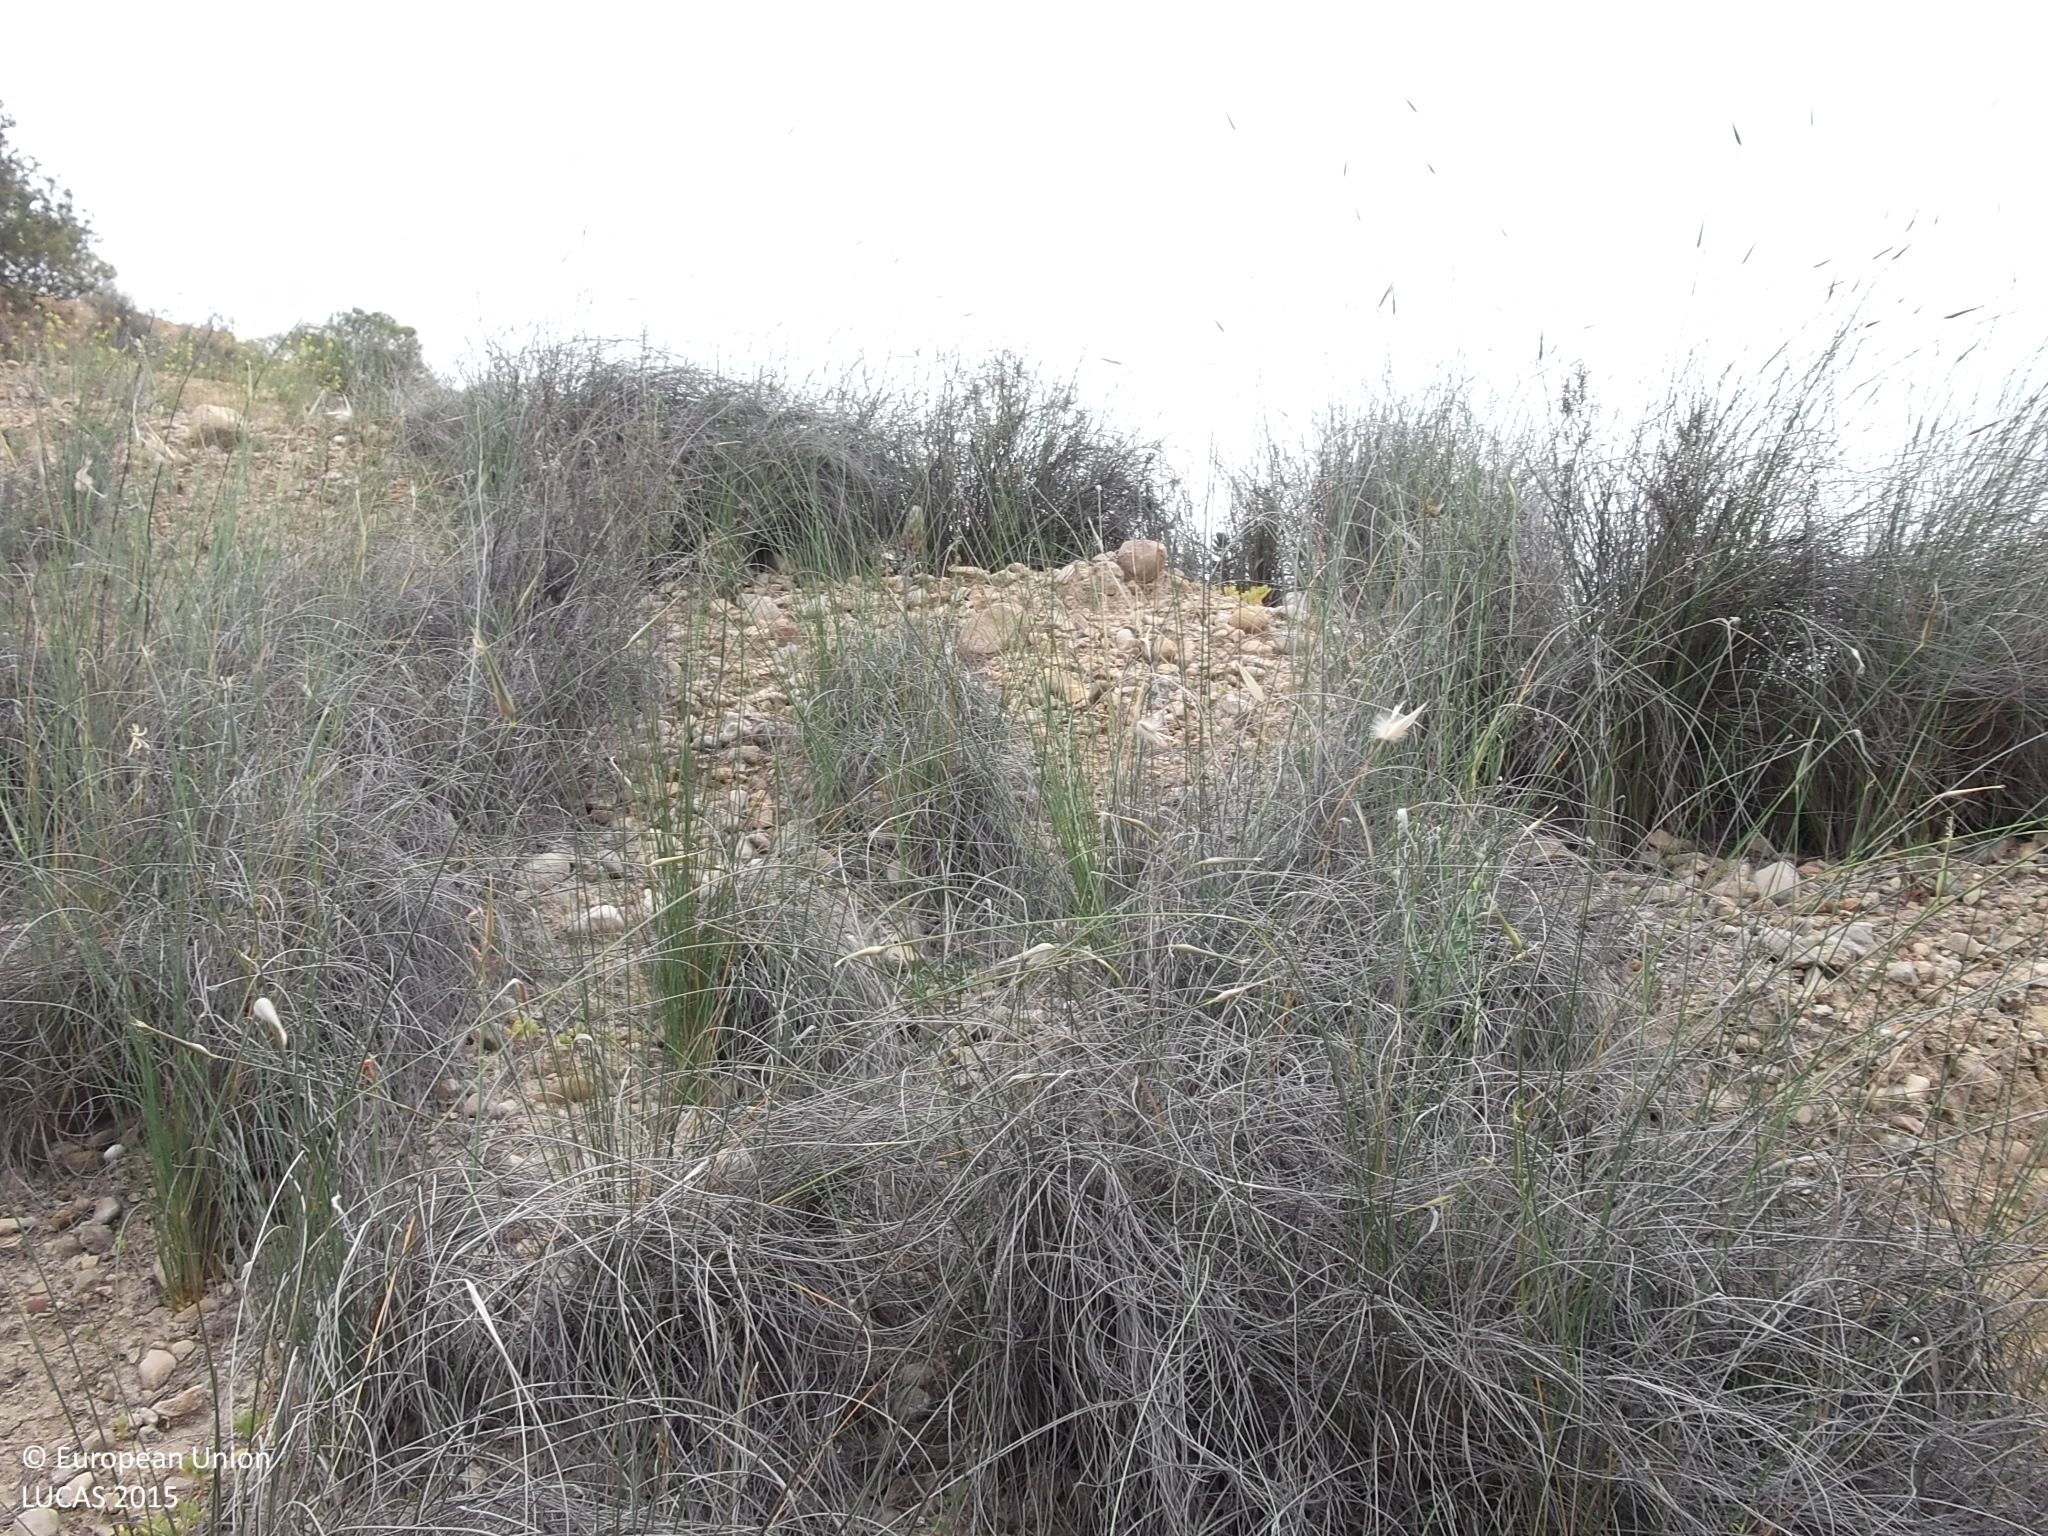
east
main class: Woodland
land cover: Pine dominated coniferous woodland
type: coniferous forest of the mediterranean region
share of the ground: 10 - 25 %
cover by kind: shrubs 40 %, consolidated bare surface 40 %, coniferous forest trees 20 %
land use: Semi-natural and natural areas not in use
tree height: > 5 m
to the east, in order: Pine dominated coniferous woodland; Paved roads, cycling and walking lanes; Pine dominated coniferous woodland
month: April
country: ES
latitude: 37.9050
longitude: -1.3686
